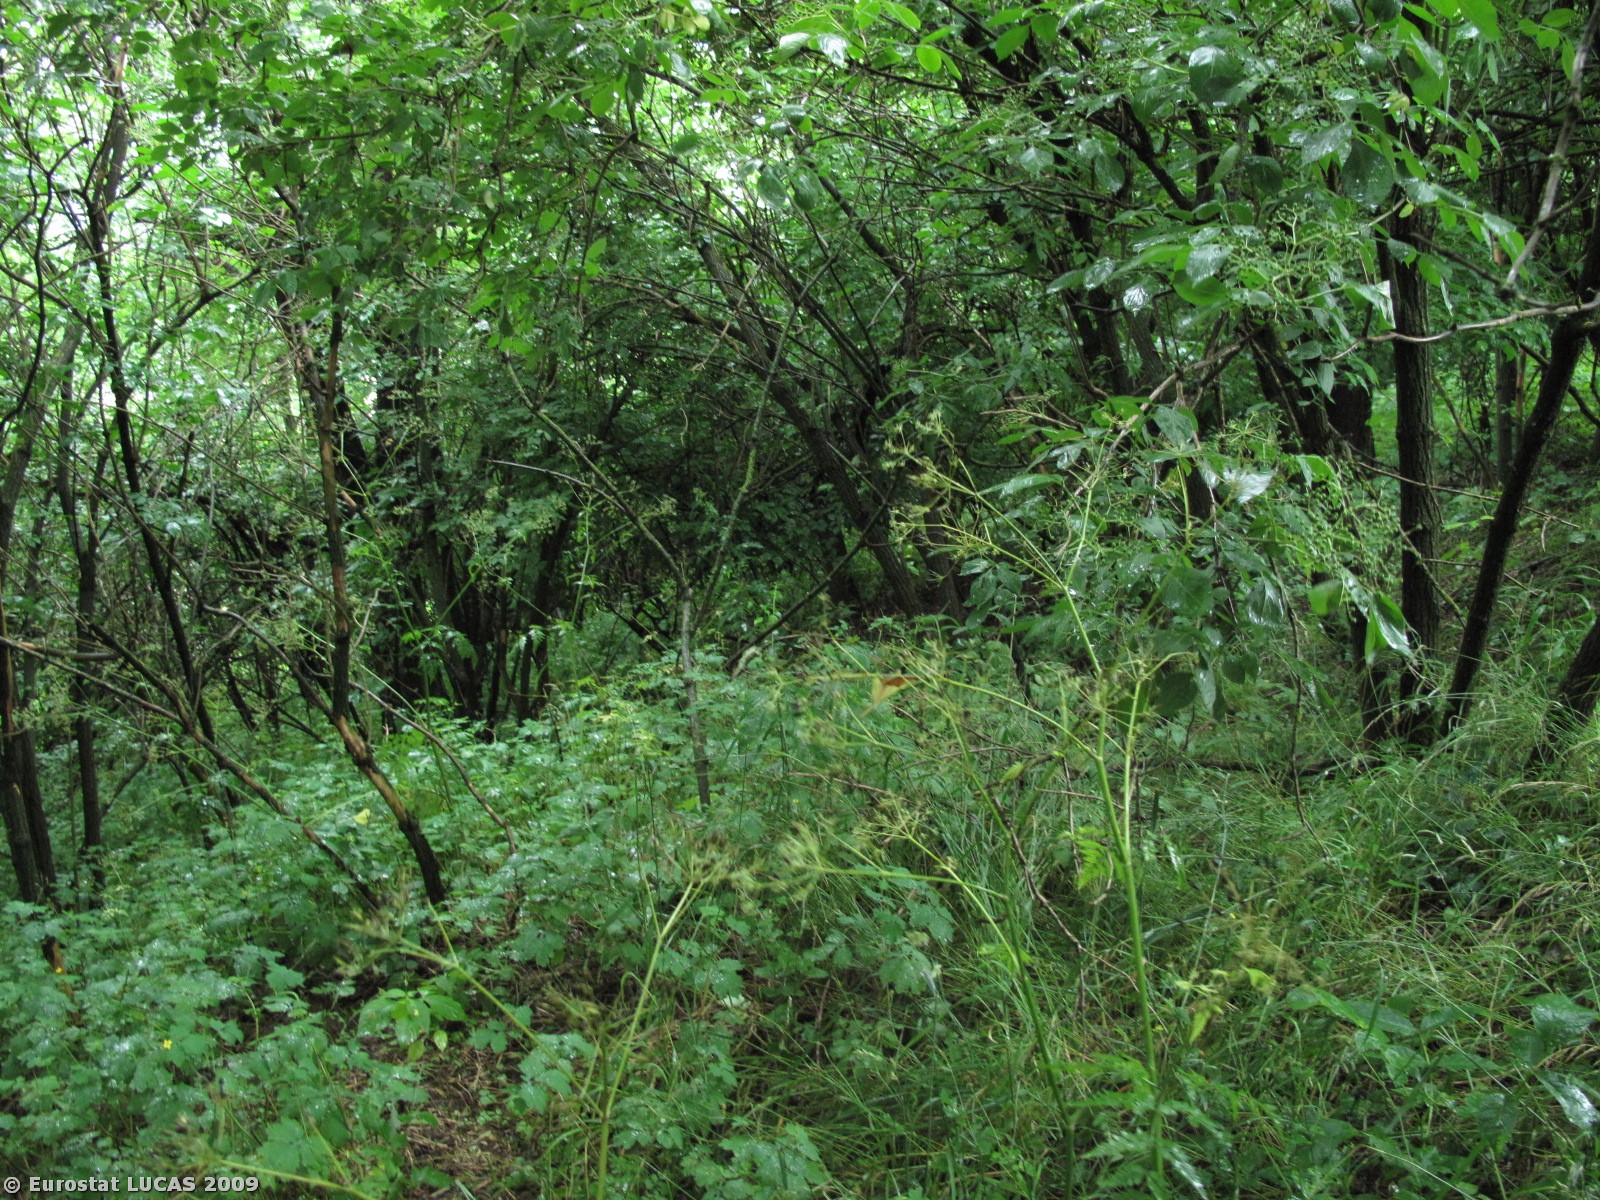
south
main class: Woodland
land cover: Broadleaved woodland
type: mesophytic deciduous forest
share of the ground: > 75 %
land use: Unused
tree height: > 5 m
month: June
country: AT
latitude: 48.2659
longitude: 15.8637
